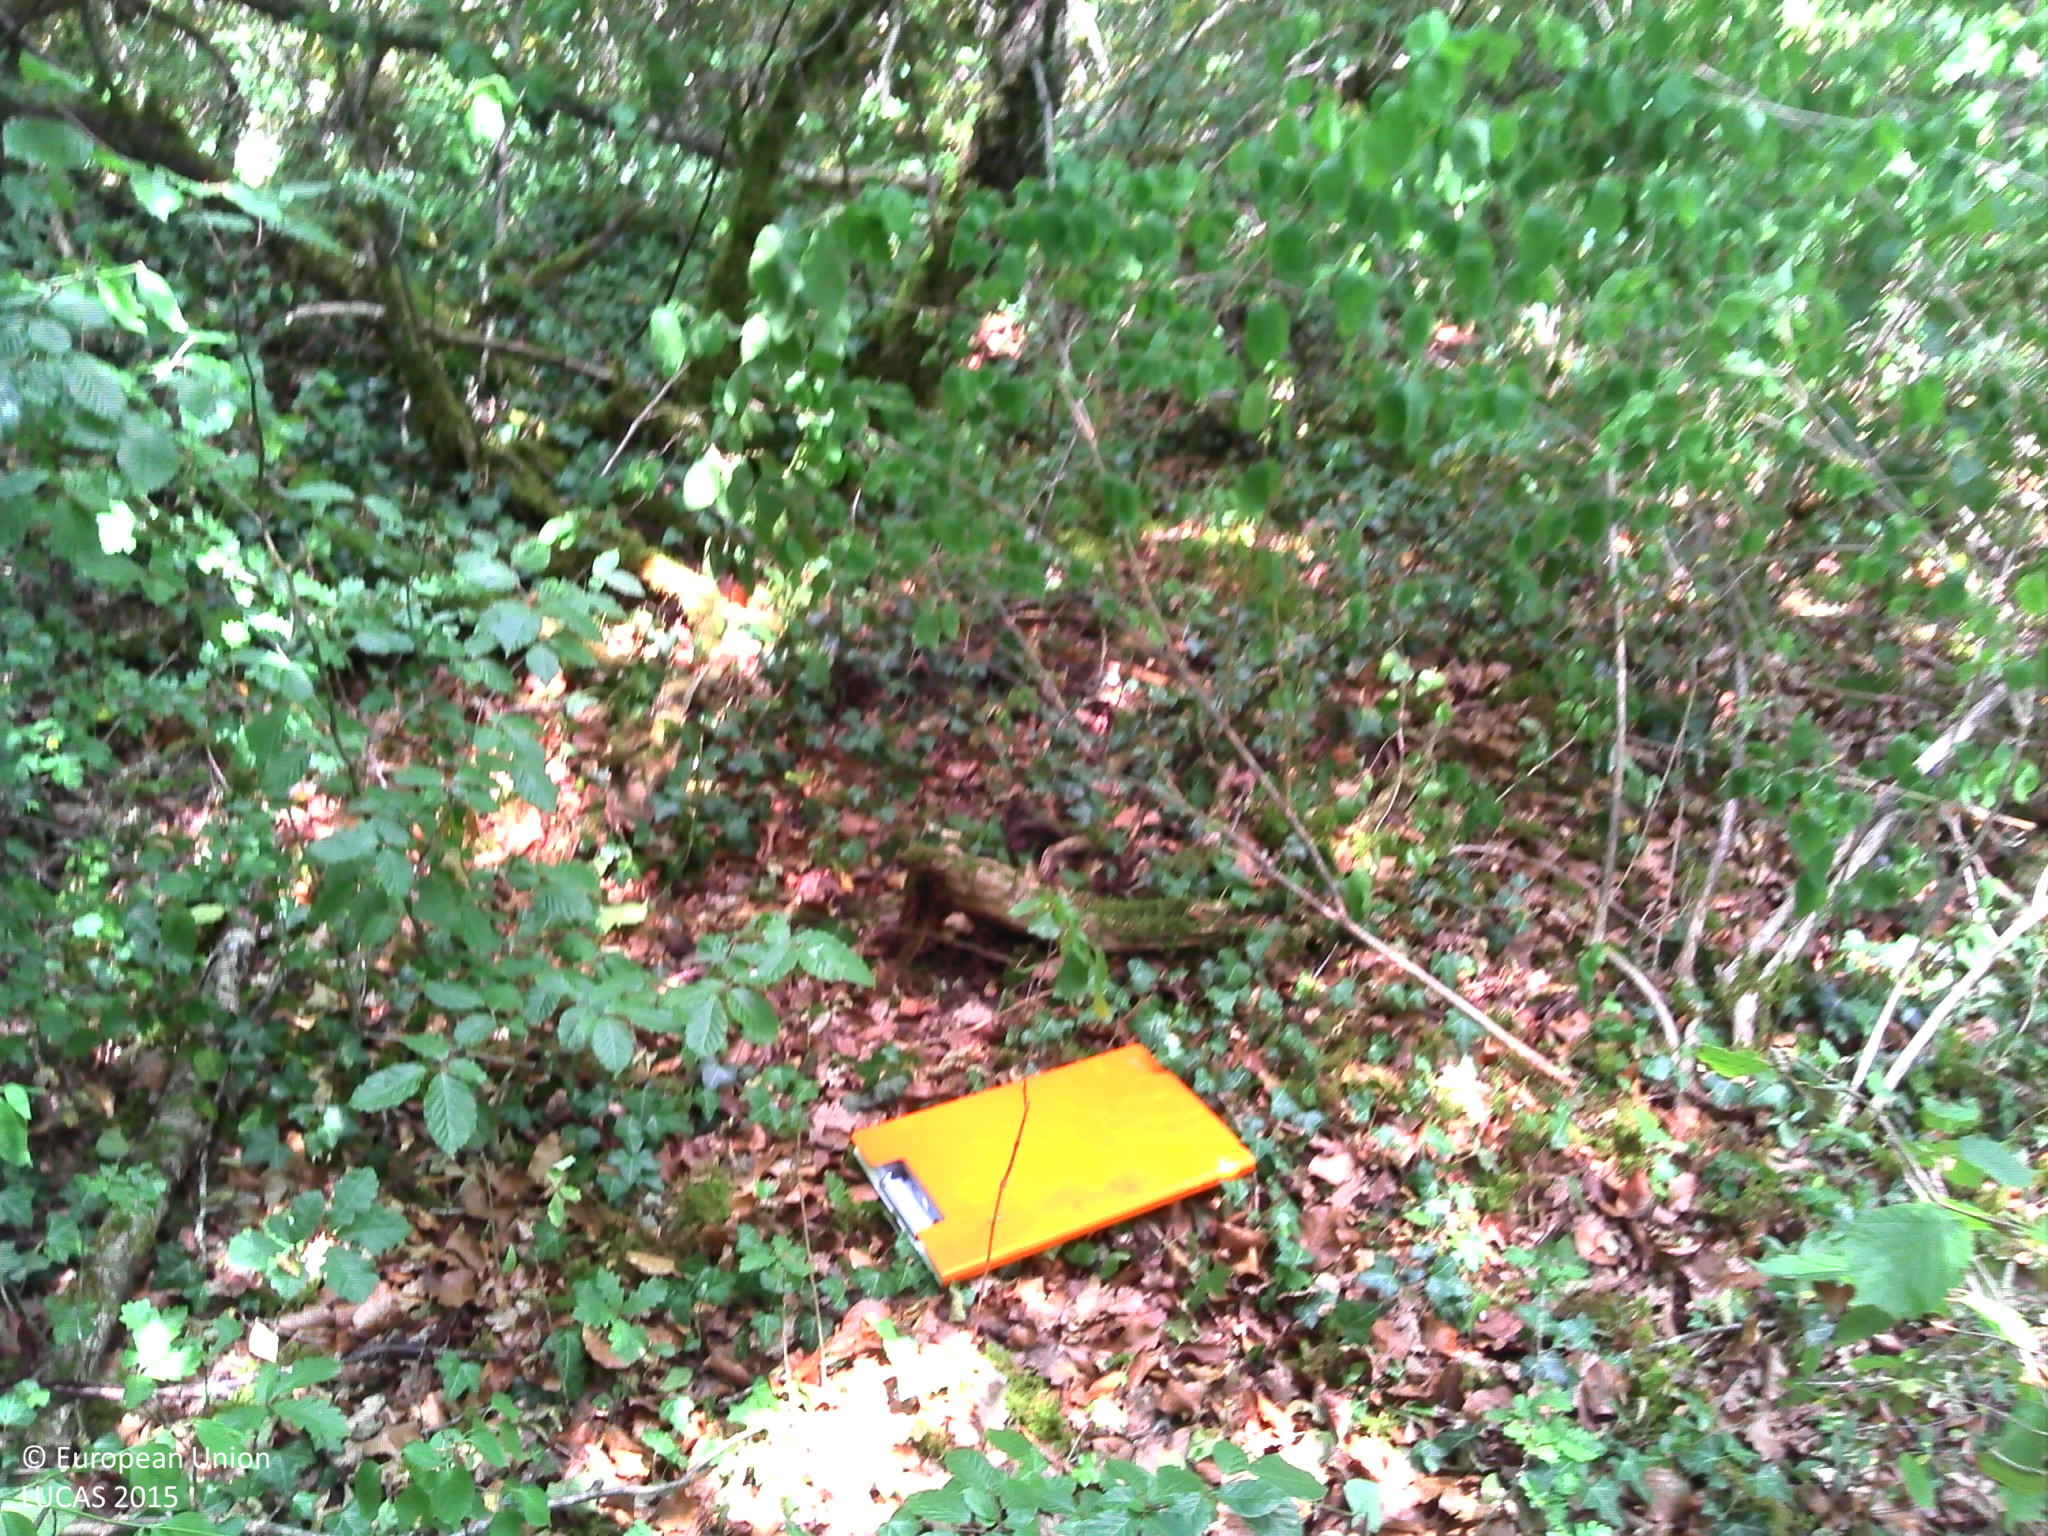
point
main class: Woodland
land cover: Broadleaved woodland
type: acidophilous oak and oak-birch forest
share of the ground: > 75 %
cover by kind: broadleaved forest trees 80 %, herbaceous plants 10 %, lichens and mosses 10 %
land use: Forestry
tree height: > 5 m
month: July
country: FR
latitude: 47.8835
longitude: 5.1722
